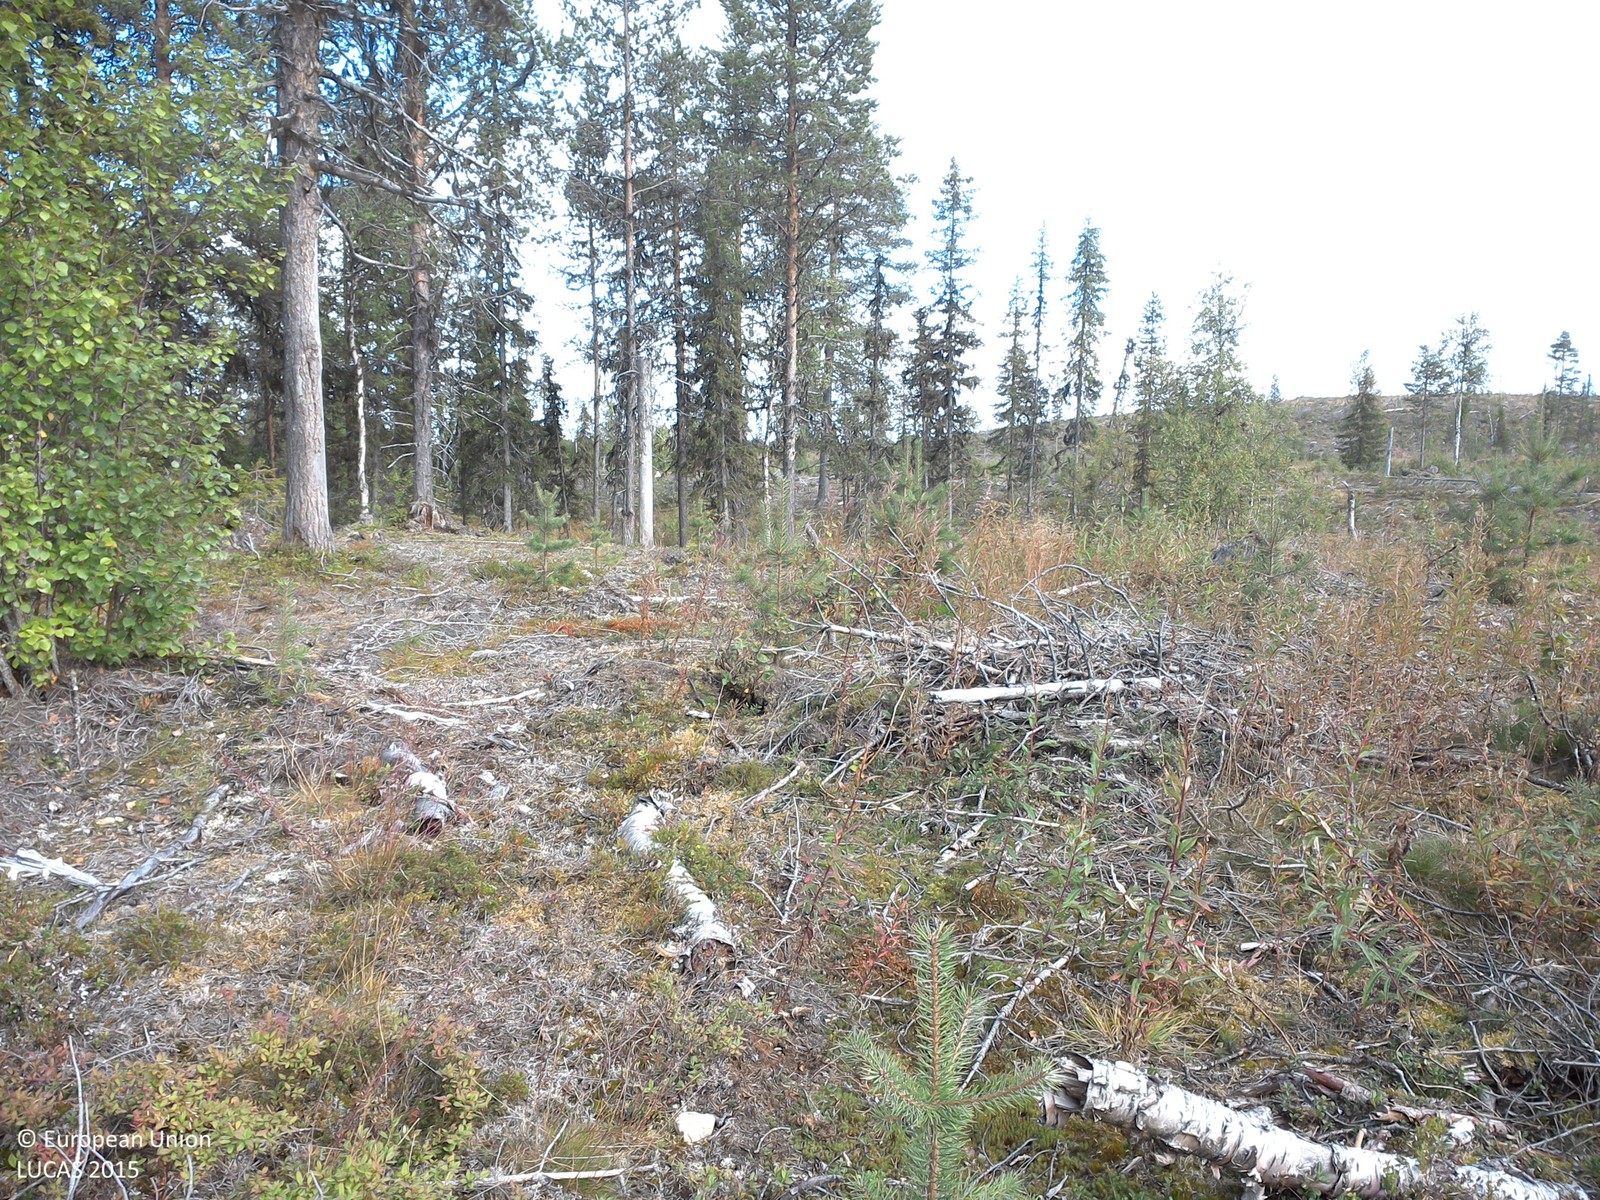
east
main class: Woodland
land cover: Pine dominated mixed woodland
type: boreal forest
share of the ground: 10 - 25 %
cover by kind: herbaceous plants 50 %, shrubs 20 %, lichens and mosses 15 %, coniferous forest trees 5 %, broadleaved forest trees 5 %, consolidated bare surface 5 %
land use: Forestry
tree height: < 5 m
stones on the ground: < 10 %
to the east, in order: Pine dominated mixed woodland; Shrubland with sparse tree cover; Broadleaved woodland; Paved roads, cycling and walking lanes; Groves; Ditches and canals; Broadleaved woodland; Pine dominated mixed woodland
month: September
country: SE
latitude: 67.8273
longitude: 23.0895
